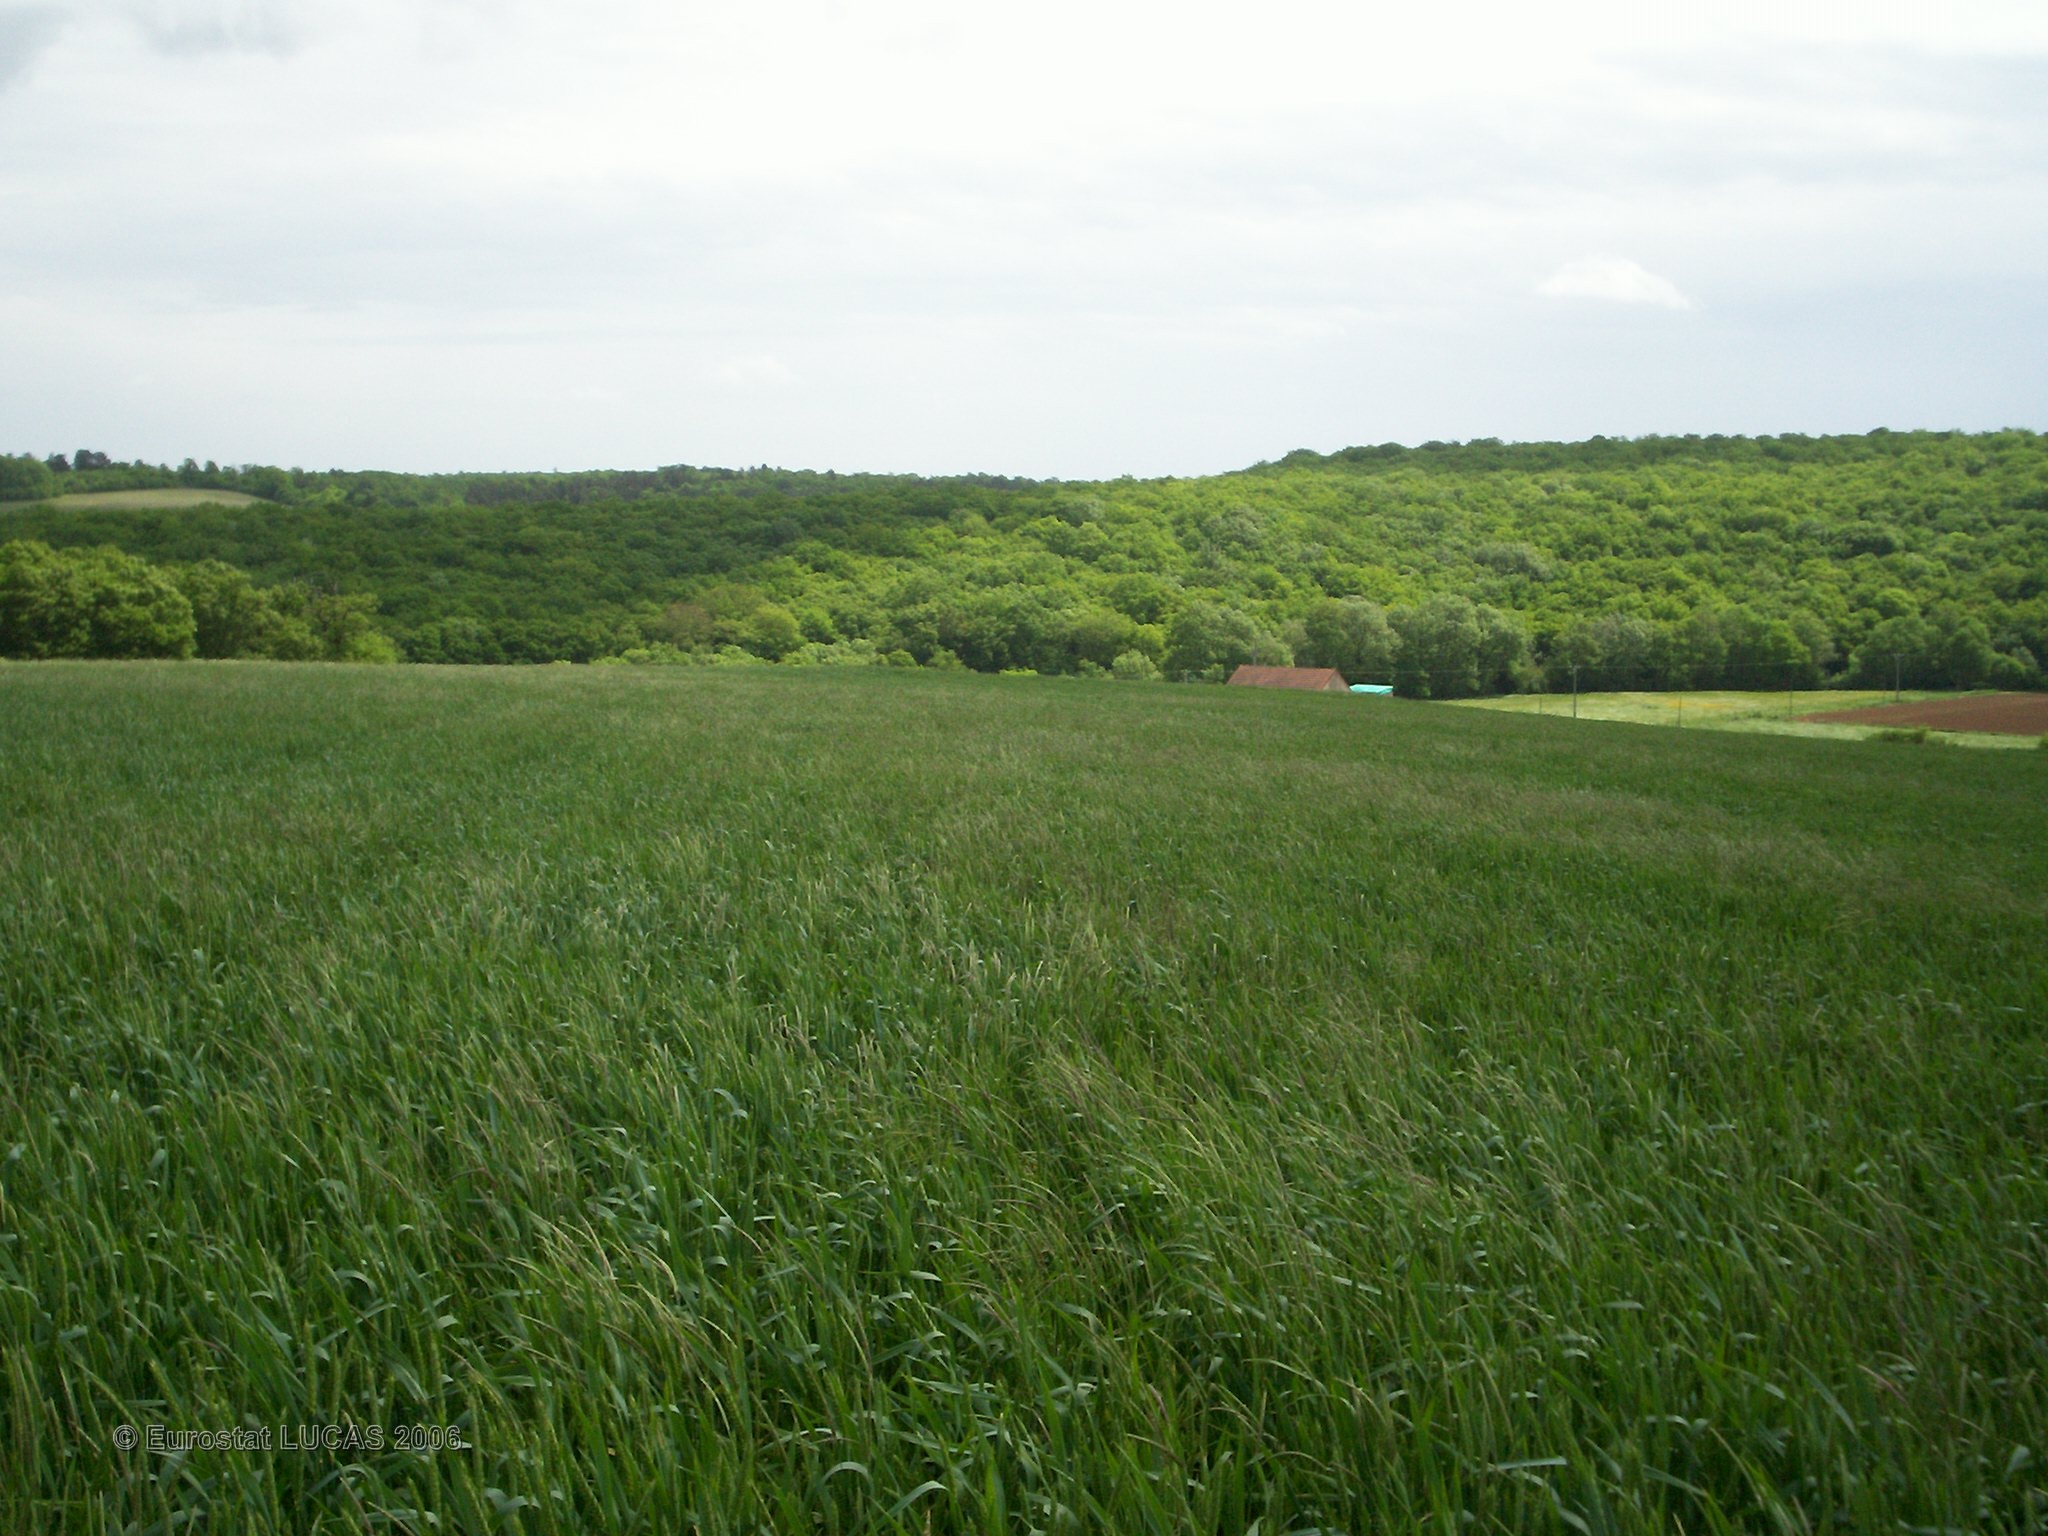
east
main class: Cropland
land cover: Durum wheat
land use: Agriculture (excluding fallow land and kitchen gardens)
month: May
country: FR
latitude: 47.6627
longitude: 3.9918
